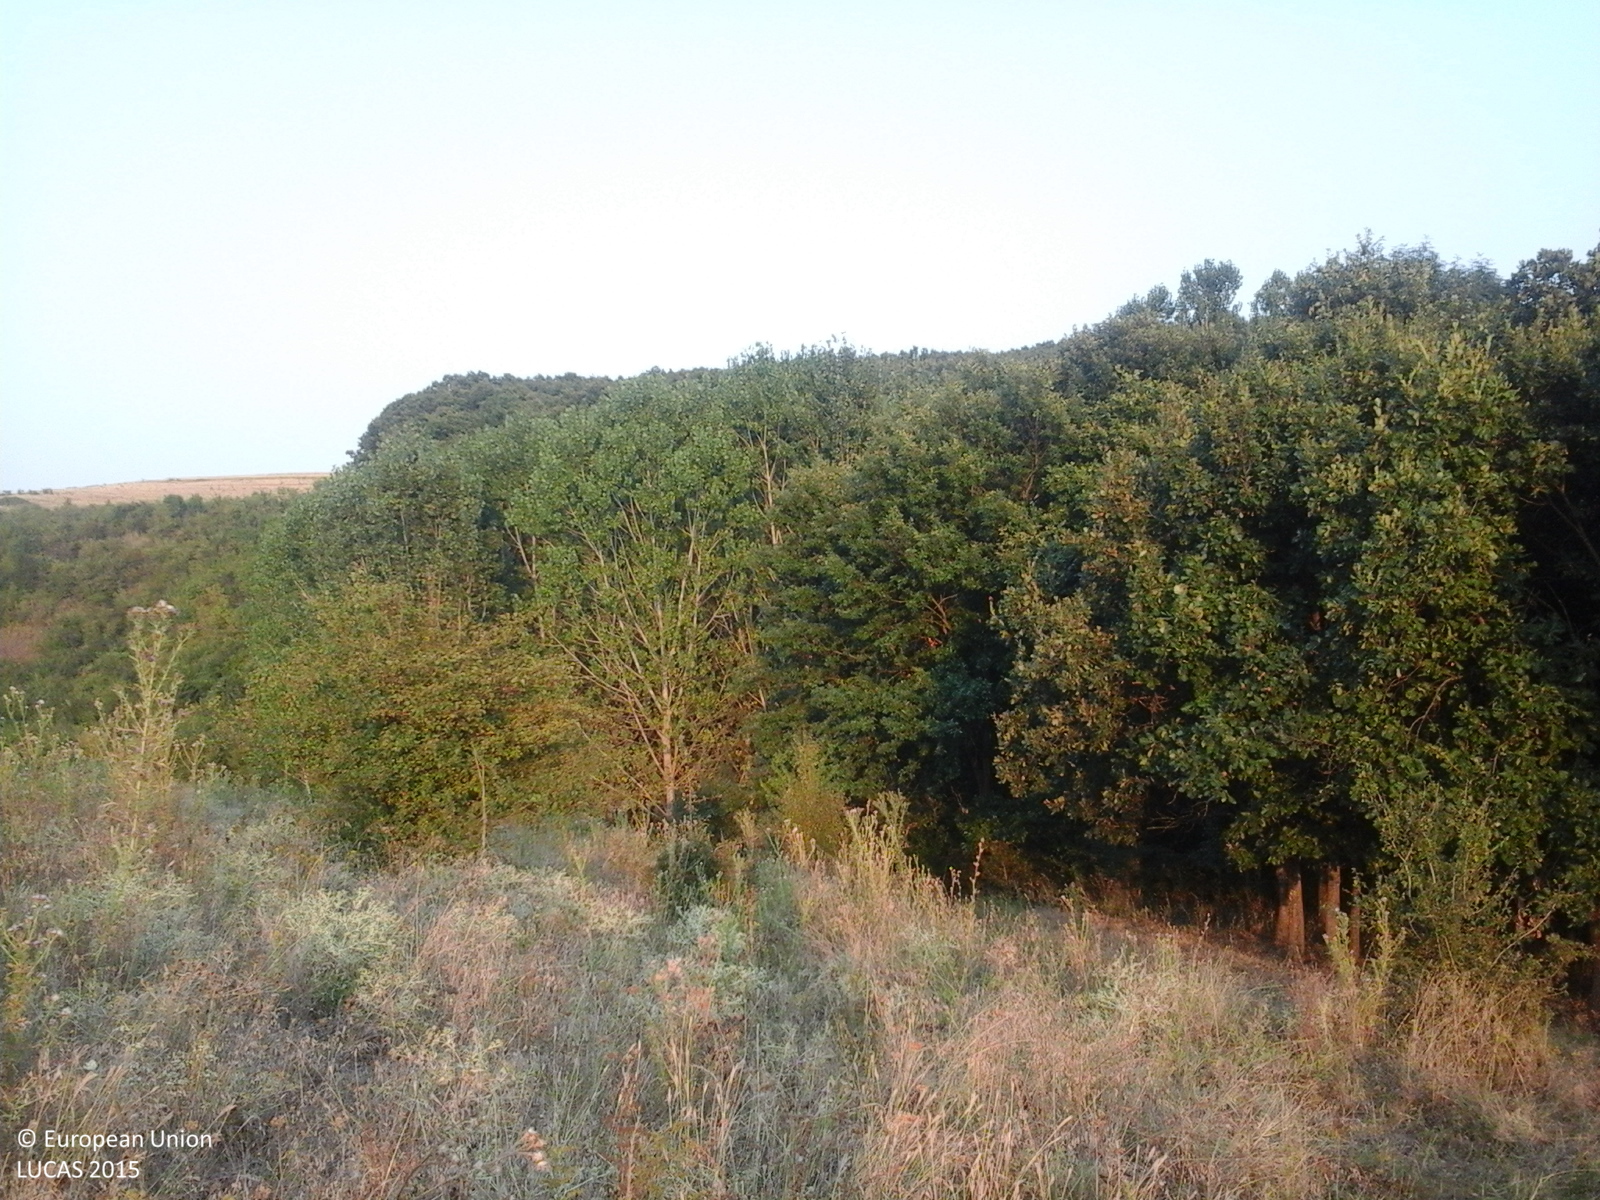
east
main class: Grassland
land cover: Grassland with sparse tree/shrub cover
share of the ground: > 75 %
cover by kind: herbaceous plants 85 %, shrubs 10 %, broadleaved forest trees 5 %
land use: Agriculture (excluding fallow land and kitchen gardens)
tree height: < 5 m
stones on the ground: < 10 %
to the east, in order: Grassland with sparse tree/shrub cover; Broadleaved woodland; Tracks; Broadleaved woodland
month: August
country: RO
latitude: 44.3195
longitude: 23.6586
